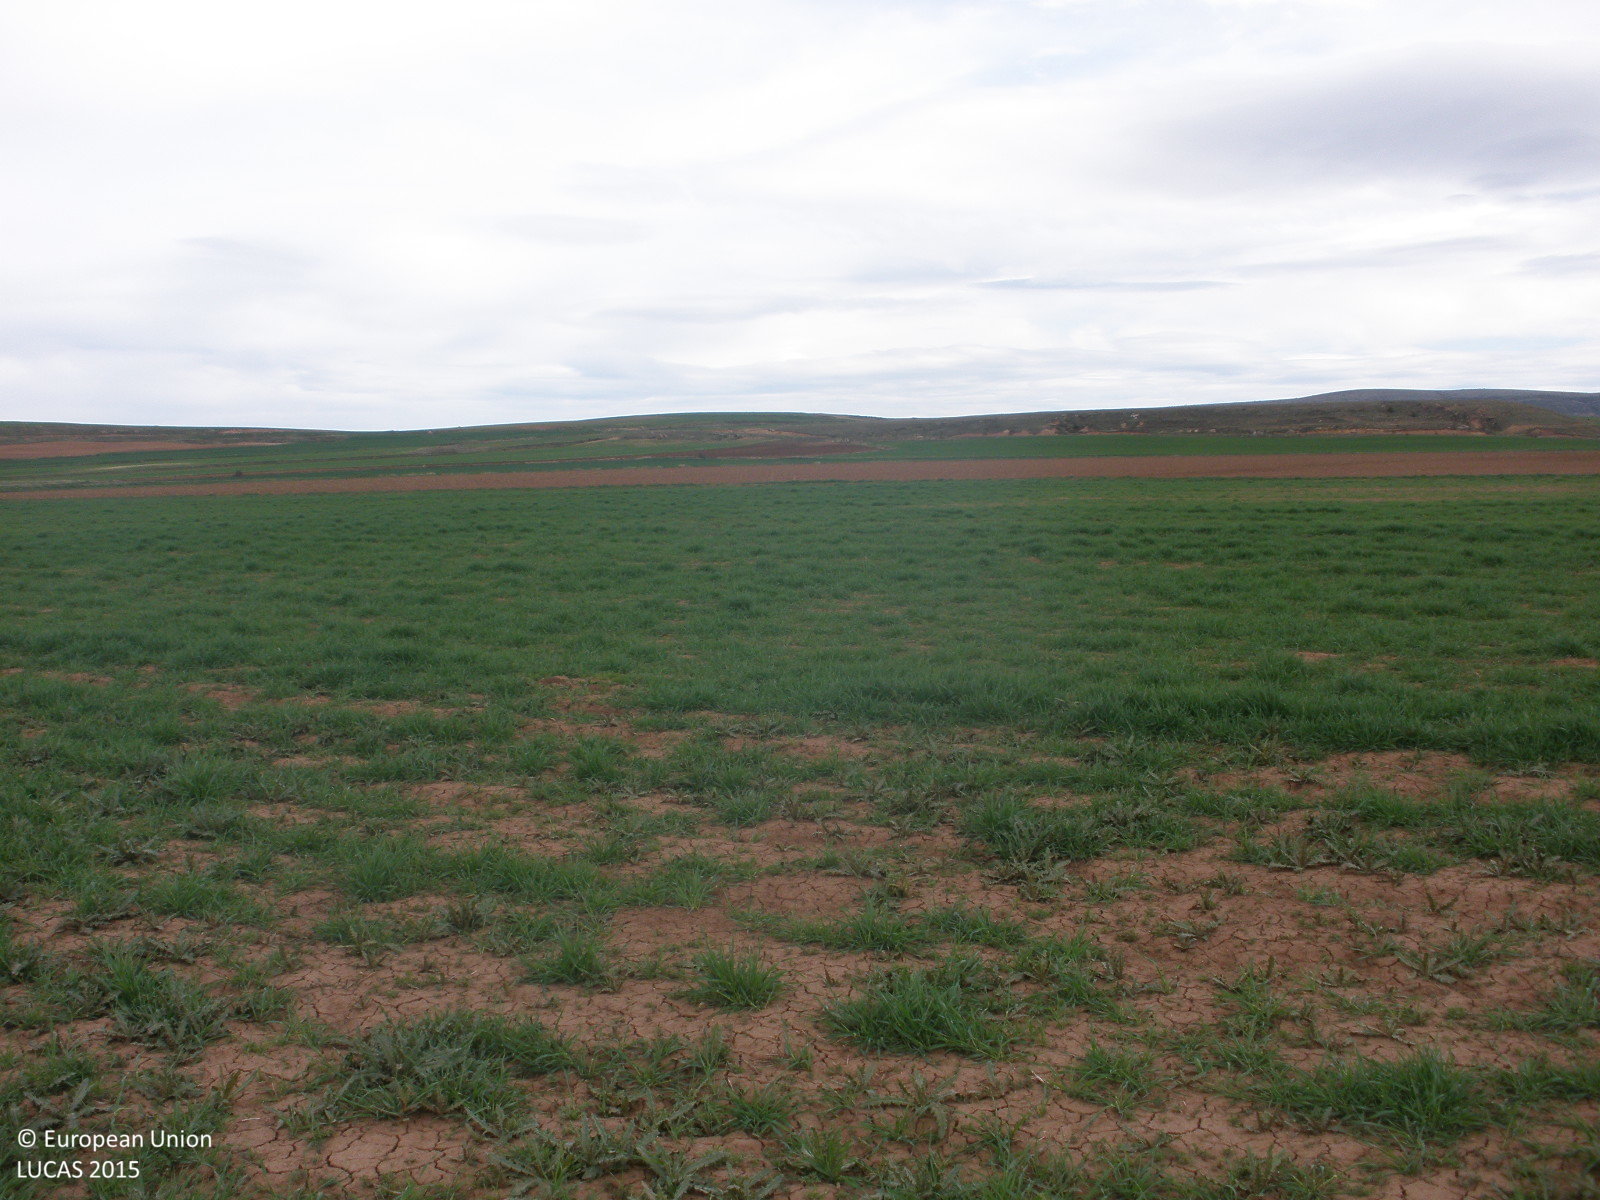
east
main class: Cropland
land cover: Barley
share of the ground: > 75 %
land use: Agriculture (excluding fallow land and kitchen gardens)
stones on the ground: < 10 %
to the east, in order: Barley; Grass margins; Other bare soil
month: May
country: ES
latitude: 40.4842
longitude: -0.8518
